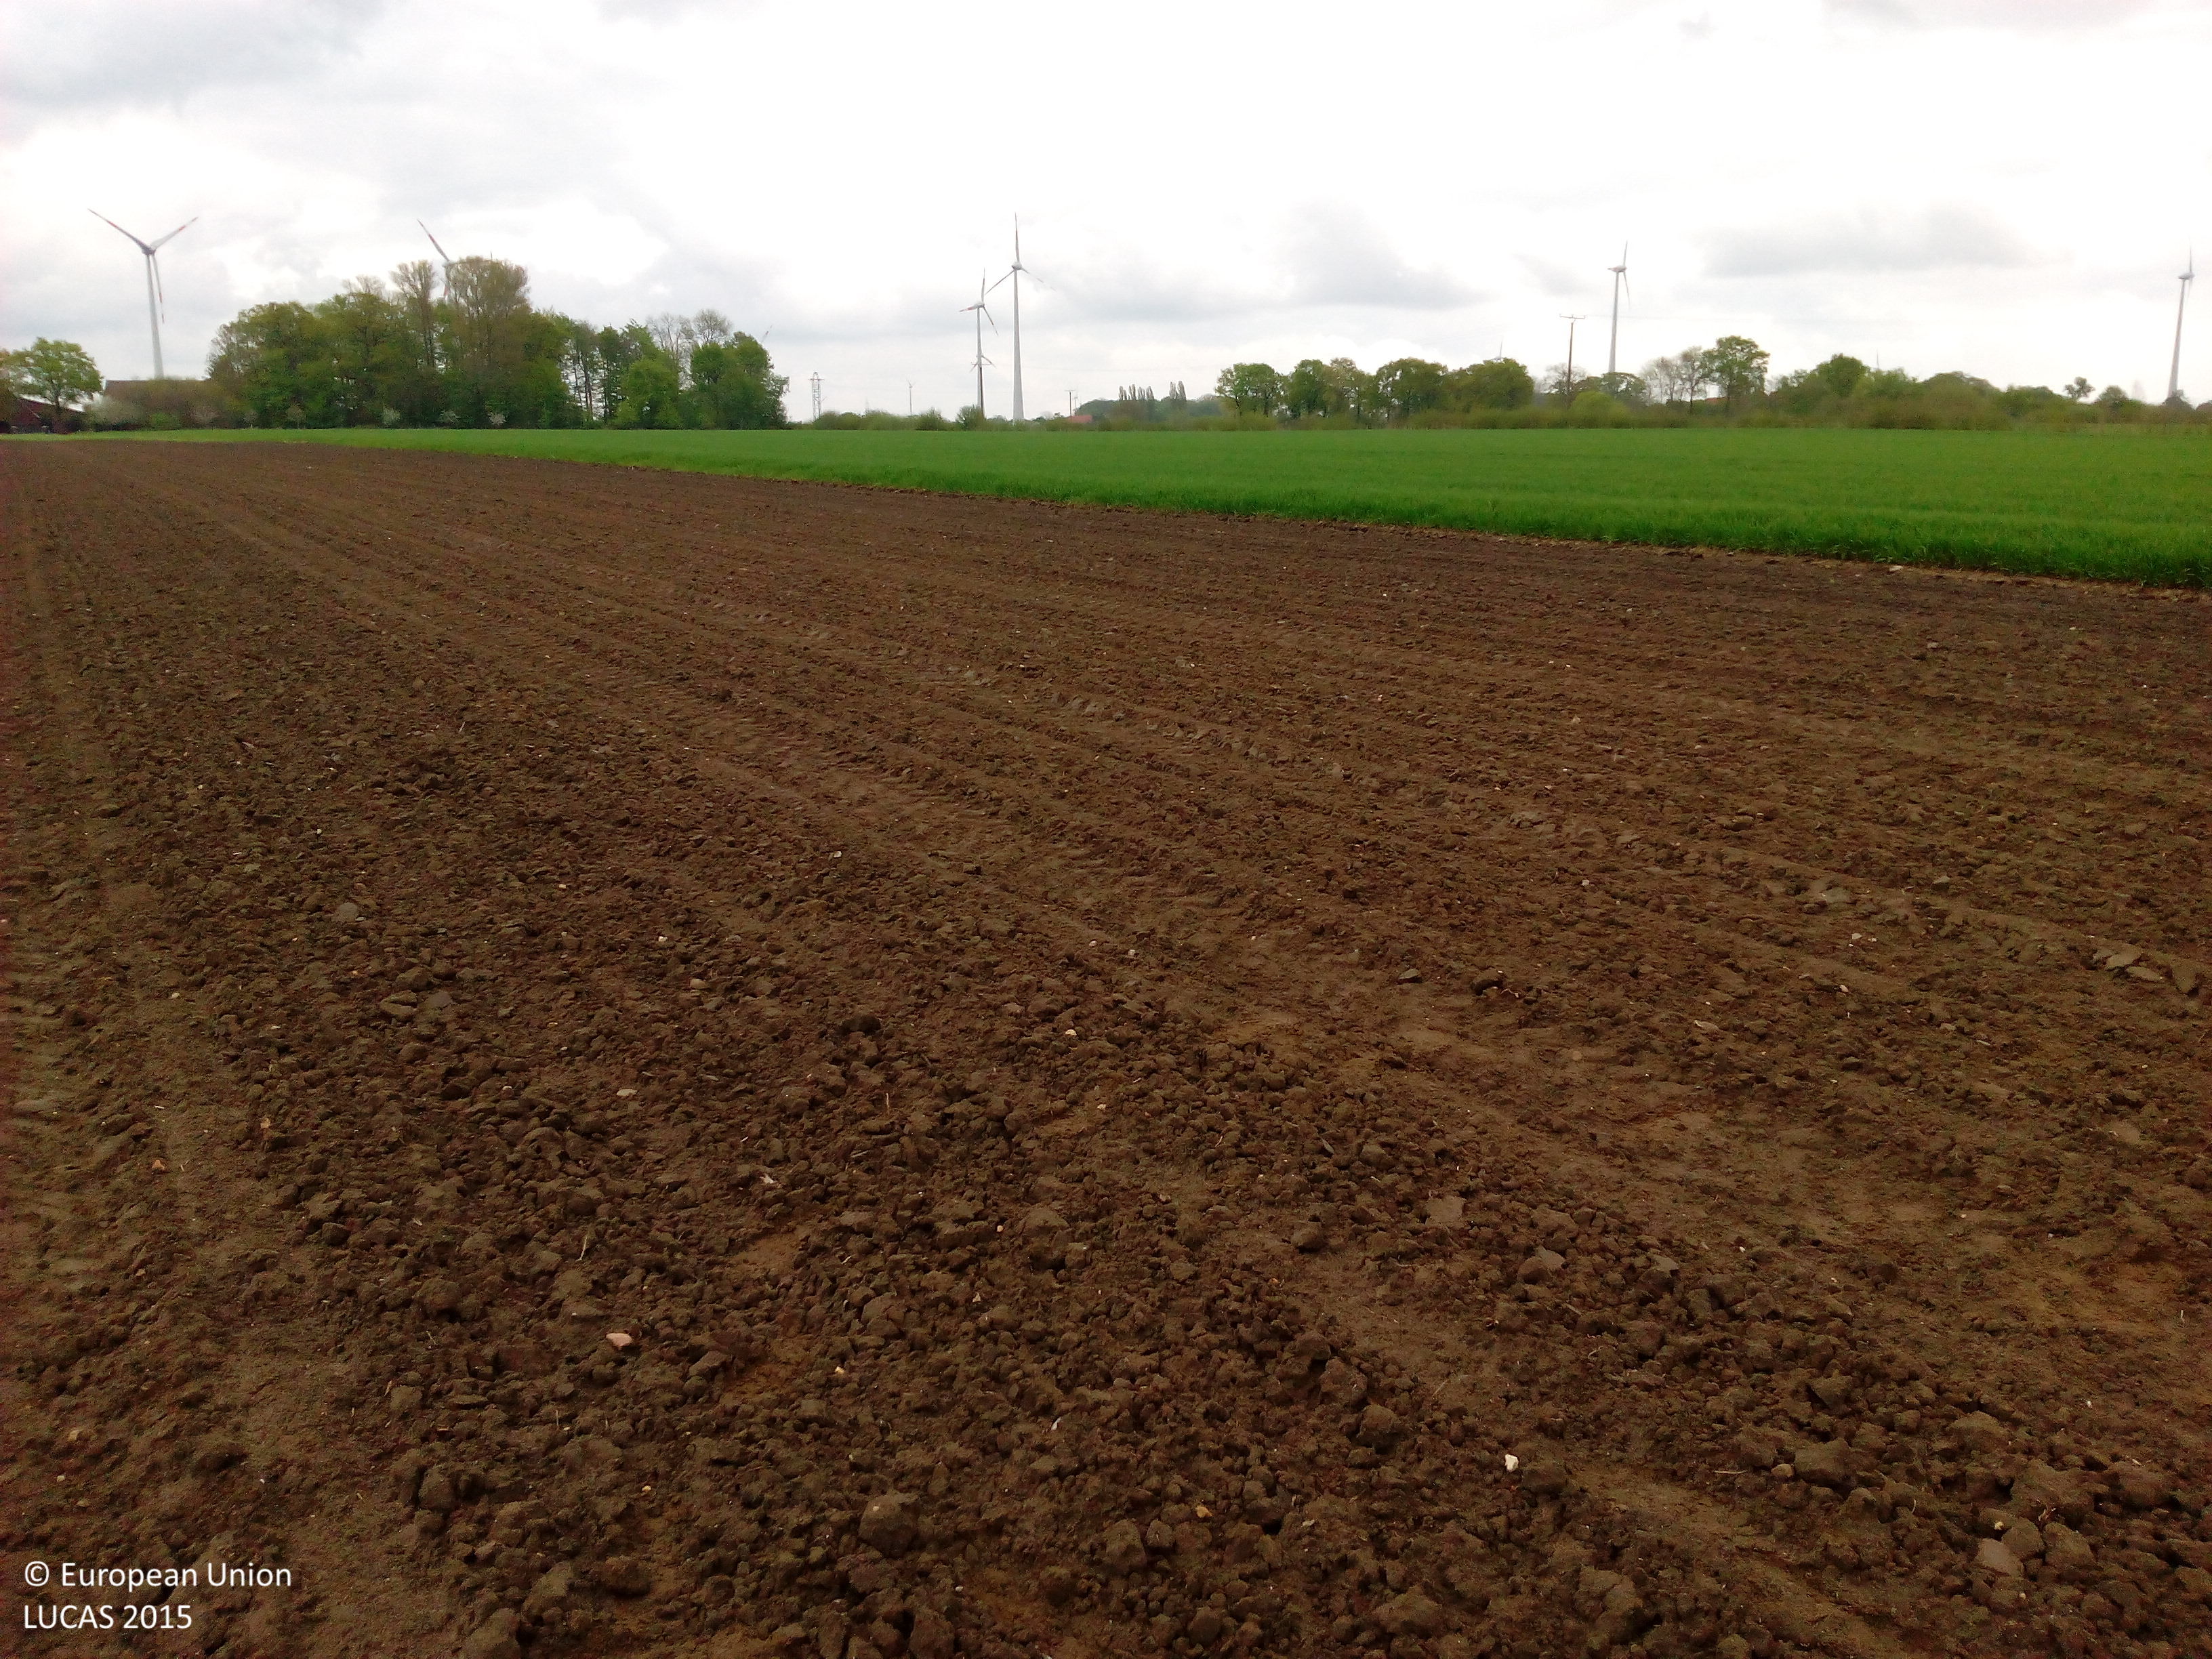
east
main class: Cropland
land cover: Maize
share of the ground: < 10 %
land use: Agriculture (excluding fallow land and kitchen gardens)
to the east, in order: Maize; Common wheat
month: May
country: DE
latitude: 52.0790
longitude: 7.3884
